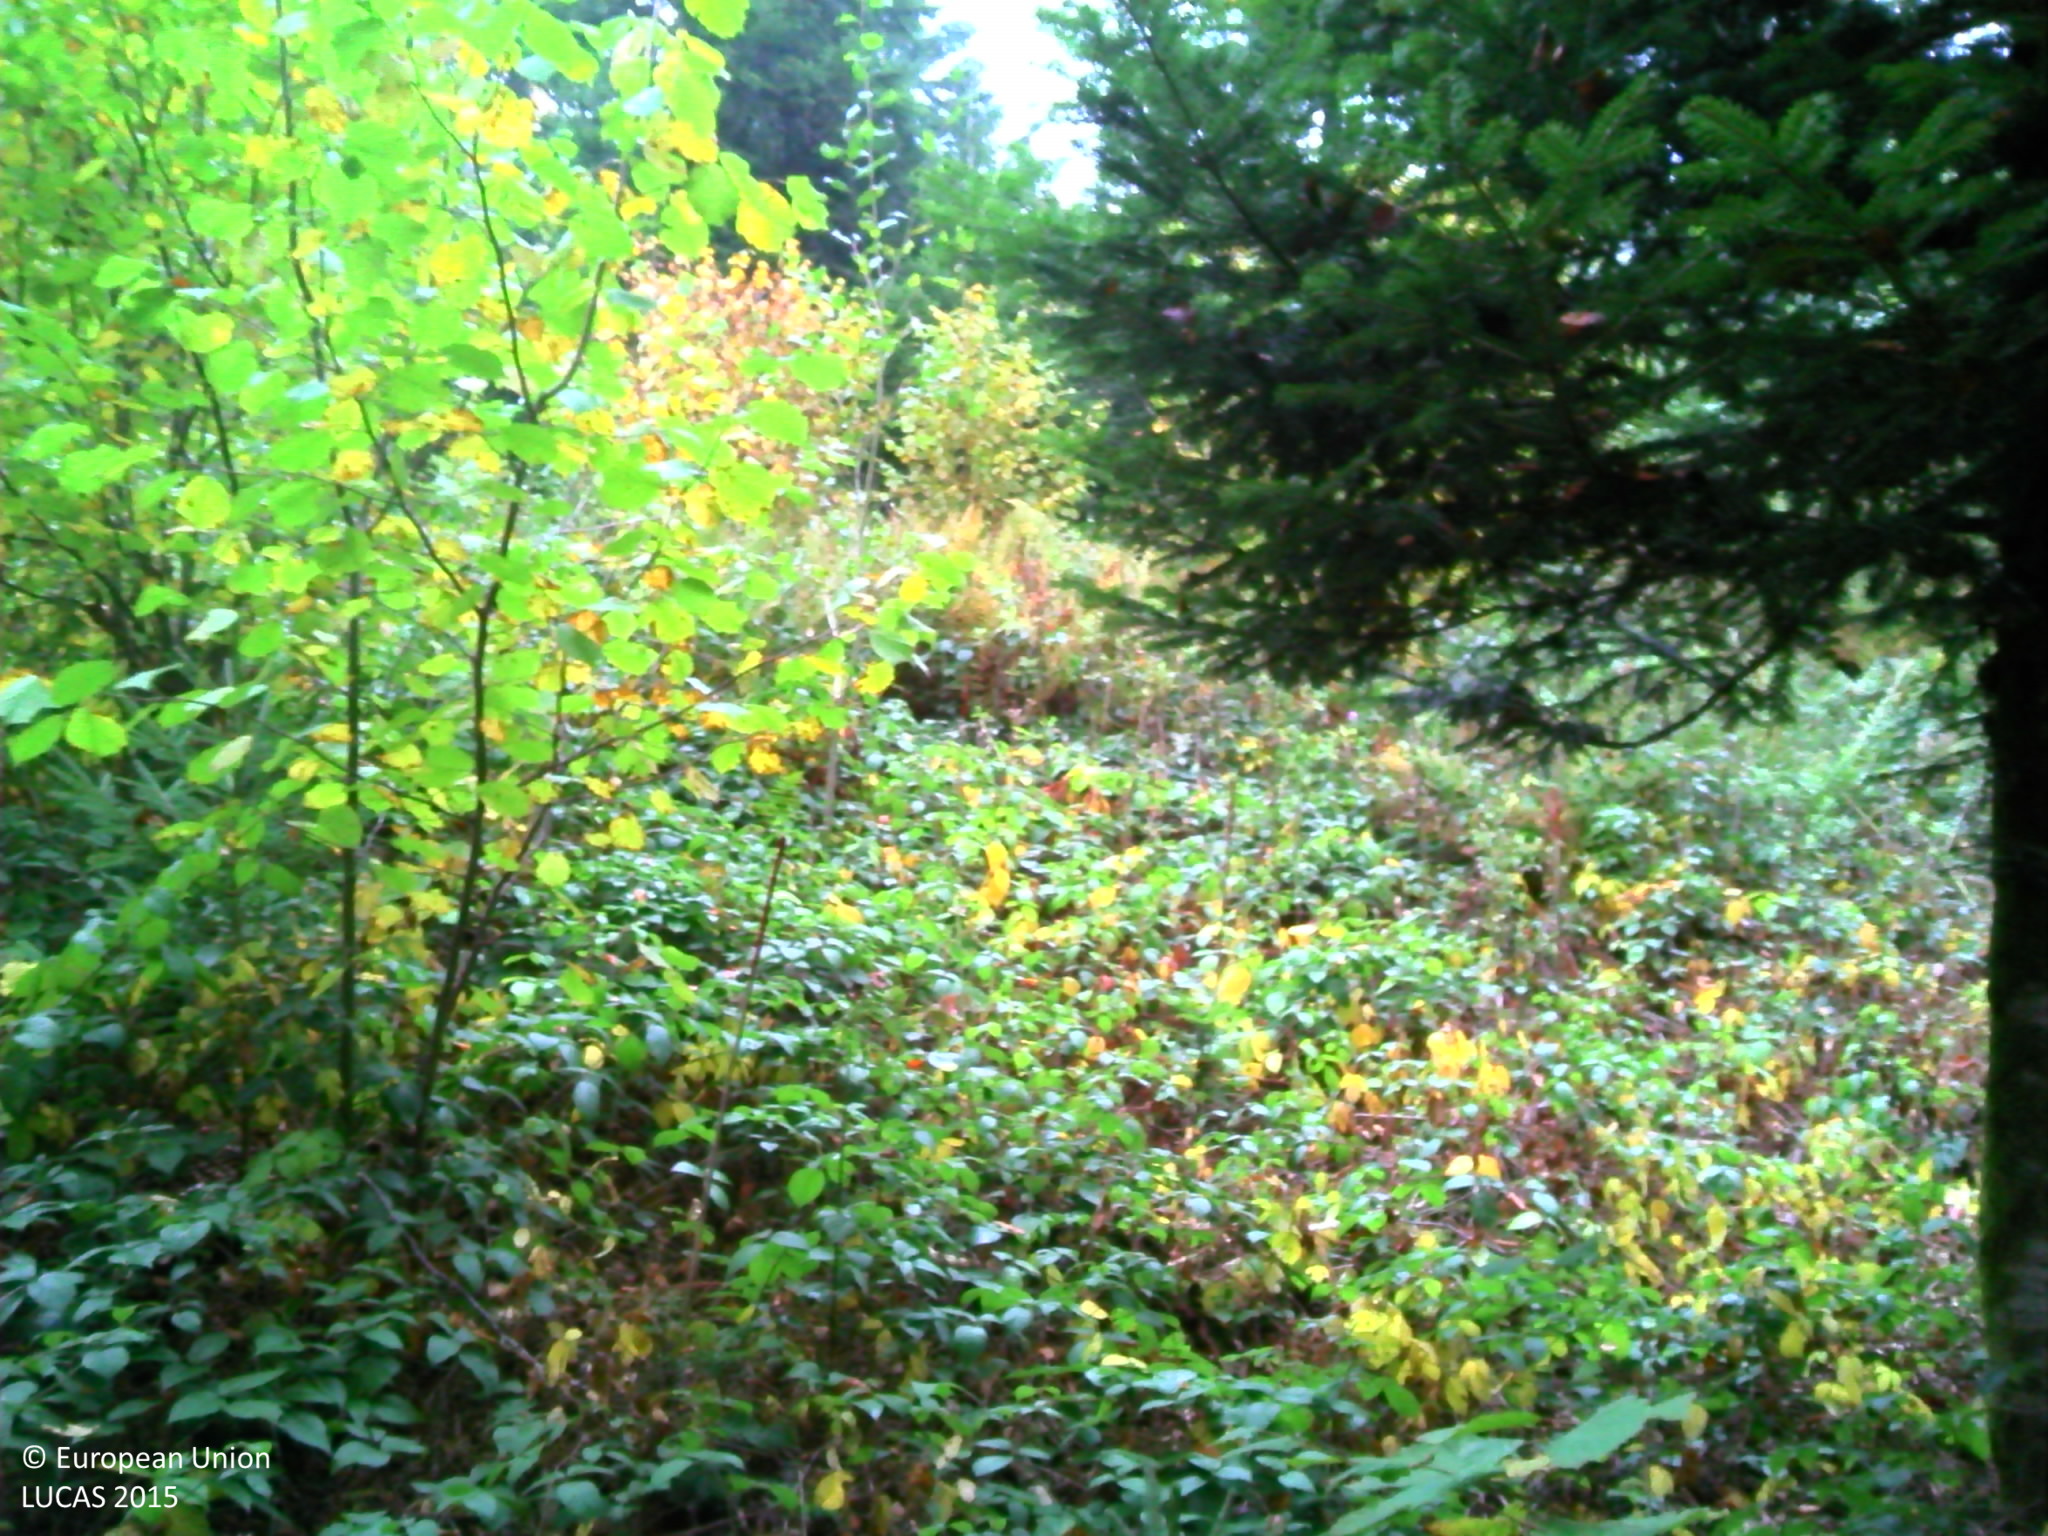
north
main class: Woodland
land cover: Spruce dominated mixed woodland
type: mountainous beech forest
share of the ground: > 75 %
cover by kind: broadleaved forest trees 60 %, coniferous forest trees 30 %, shrubs 5 %, unconsolidated bare surface 5 %
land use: Forestry
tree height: > 5 m
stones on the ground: < 10 %
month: October
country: FR
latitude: 46.8942
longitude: 6.1304
